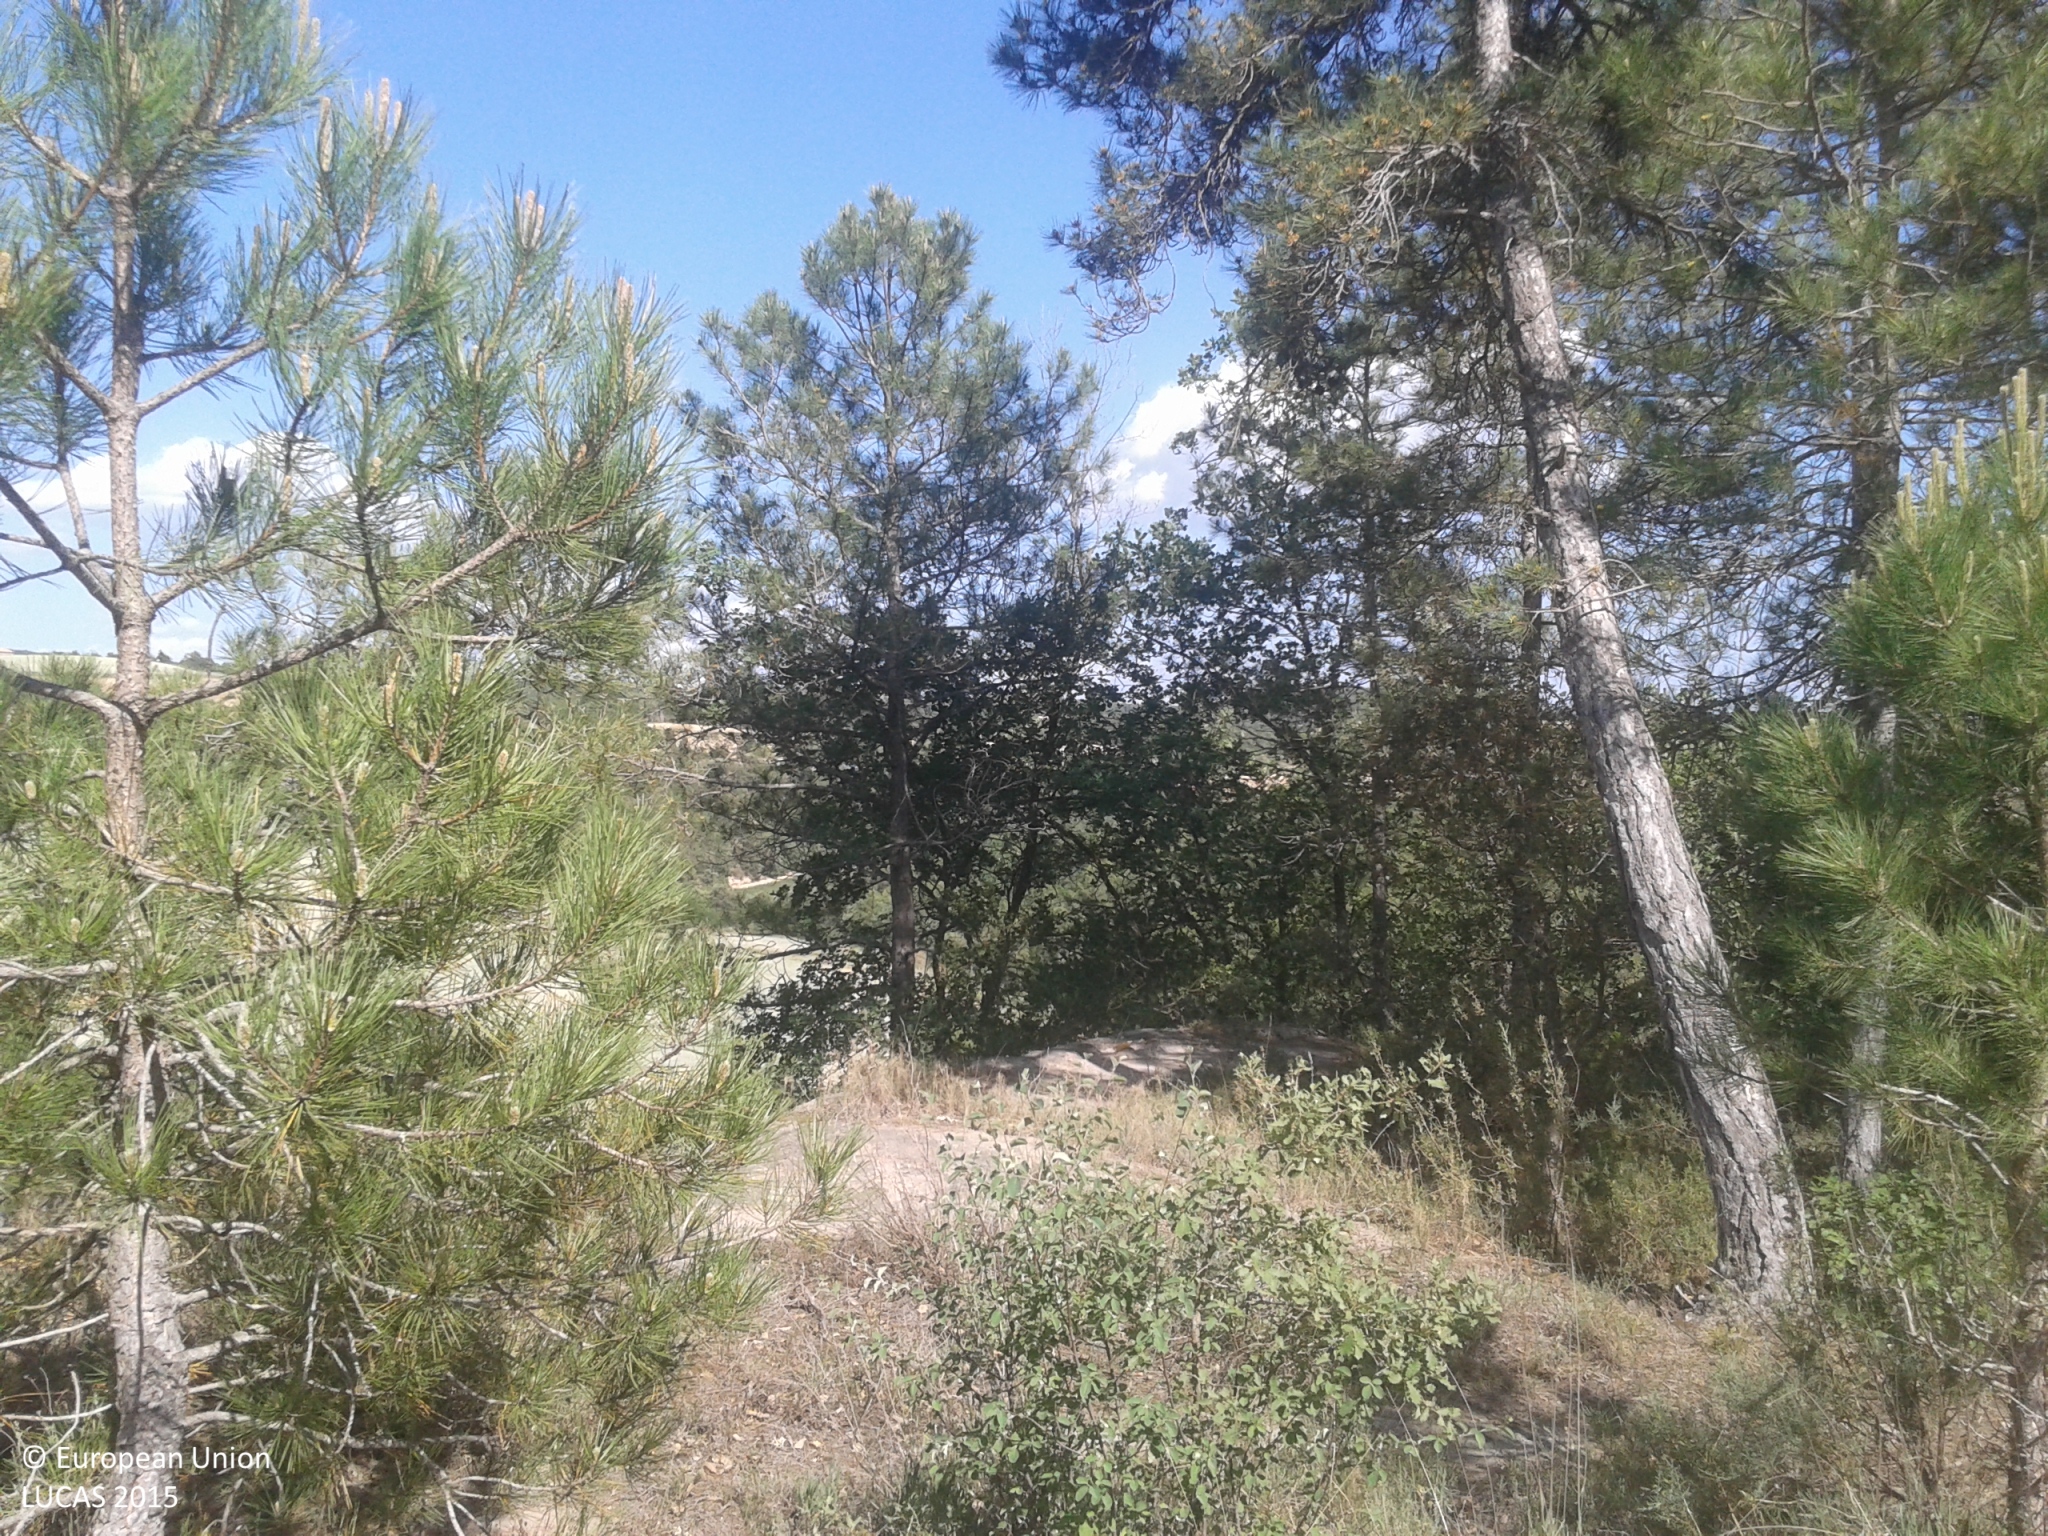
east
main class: Woodland
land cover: Pine dominated mixed woodland
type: coniferous forest of the mediterranean region
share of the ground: > 75 %
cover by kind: coniferous forest trees 60 %, broadleaved forest trees 25 %, shrubs 15 %
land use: Forestry
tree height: > 5 m
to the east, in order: Pine dominated mixed woodland; Paved roads, cycling and walking lanes; Pine dominated mixed woodland; Tracks; Other mixed woodland; Inland fresh running water; Pine dominated mixed woodland; Common wheat; Tracks; Grassland with sparse tree/shrub cover; Artificial constructions in urban areas
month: May
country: ES
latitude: 41.9999
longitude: 1.6465
